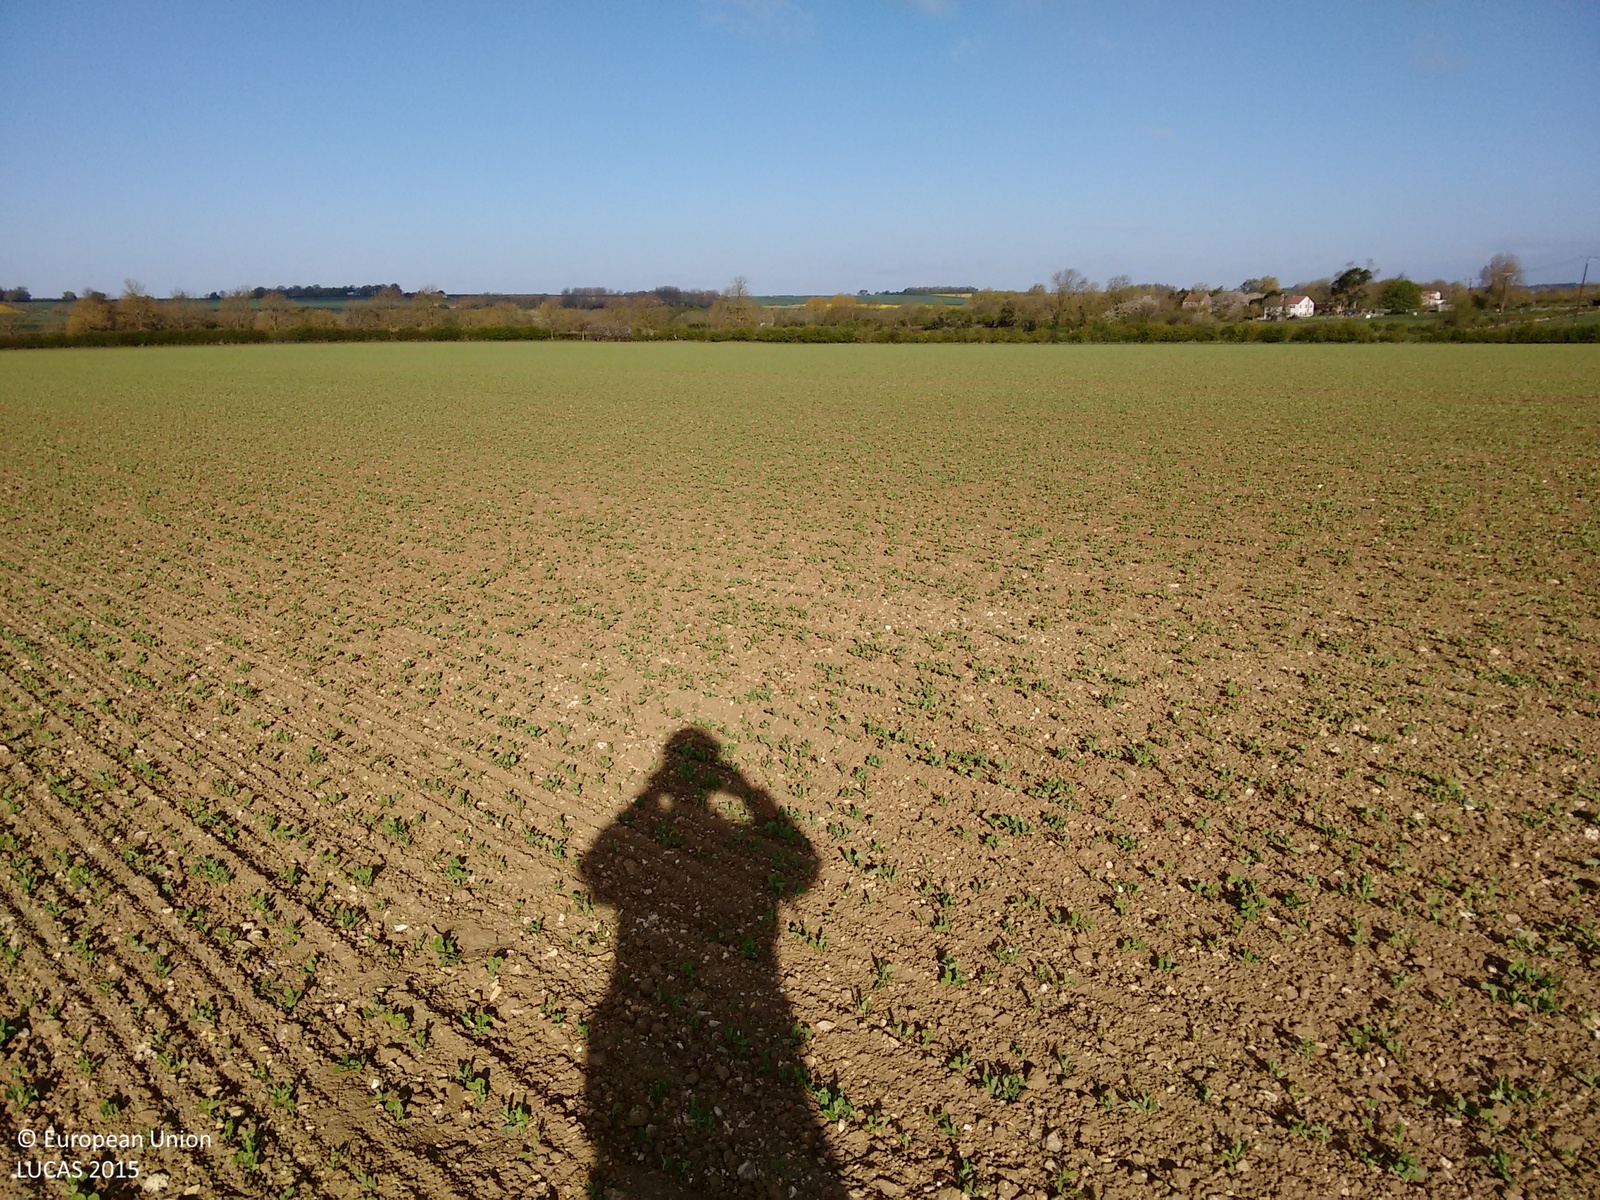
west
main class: Cropland
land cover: Dry pulses
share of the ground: < 10 %
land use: Agriculture (excluding fallow land and kitchen gardens)
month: April
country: GB
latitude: 53.2311
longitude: -0.1153
